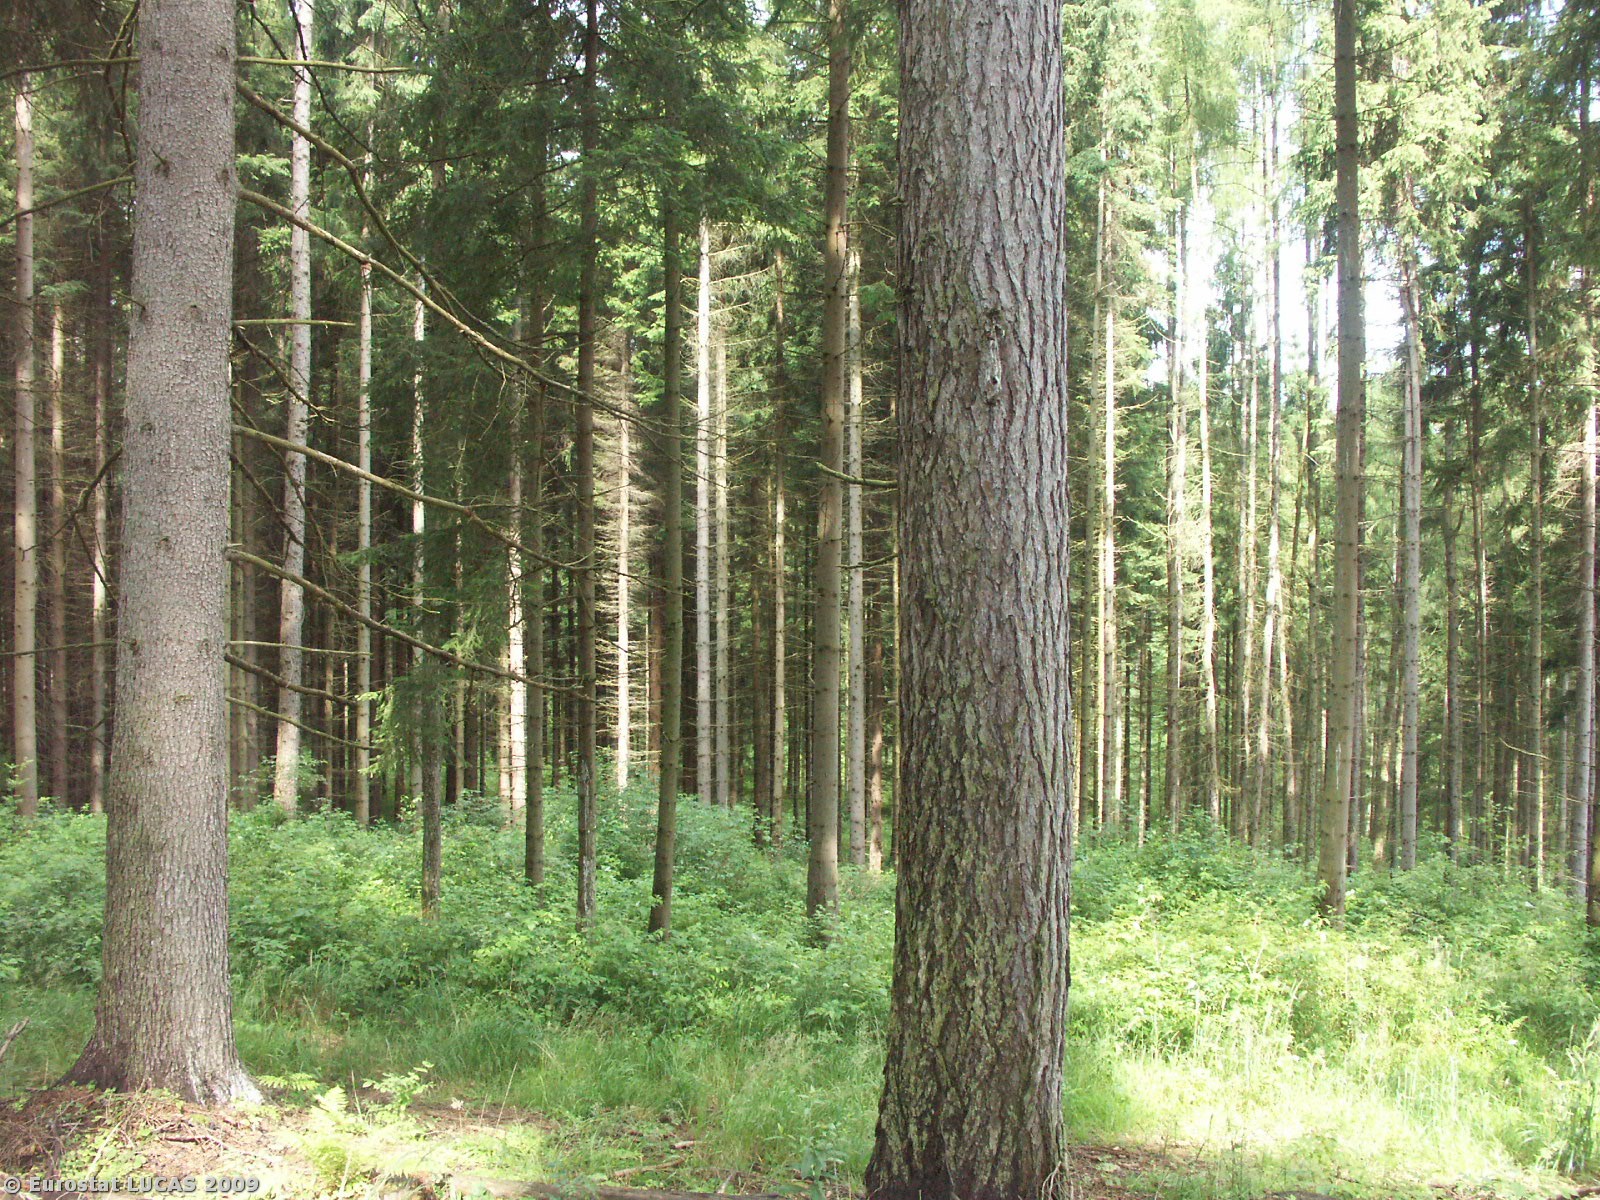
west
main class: Woodland
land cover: Coniferous woodland
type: hemiboreal forest and nemoral coniferous forest and mixed broadleaved-coniferous forest
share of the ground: > 75 %
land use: Forestry
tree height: > 5 m
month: July
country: CZ
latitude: 49.9429
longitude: 17.4111
